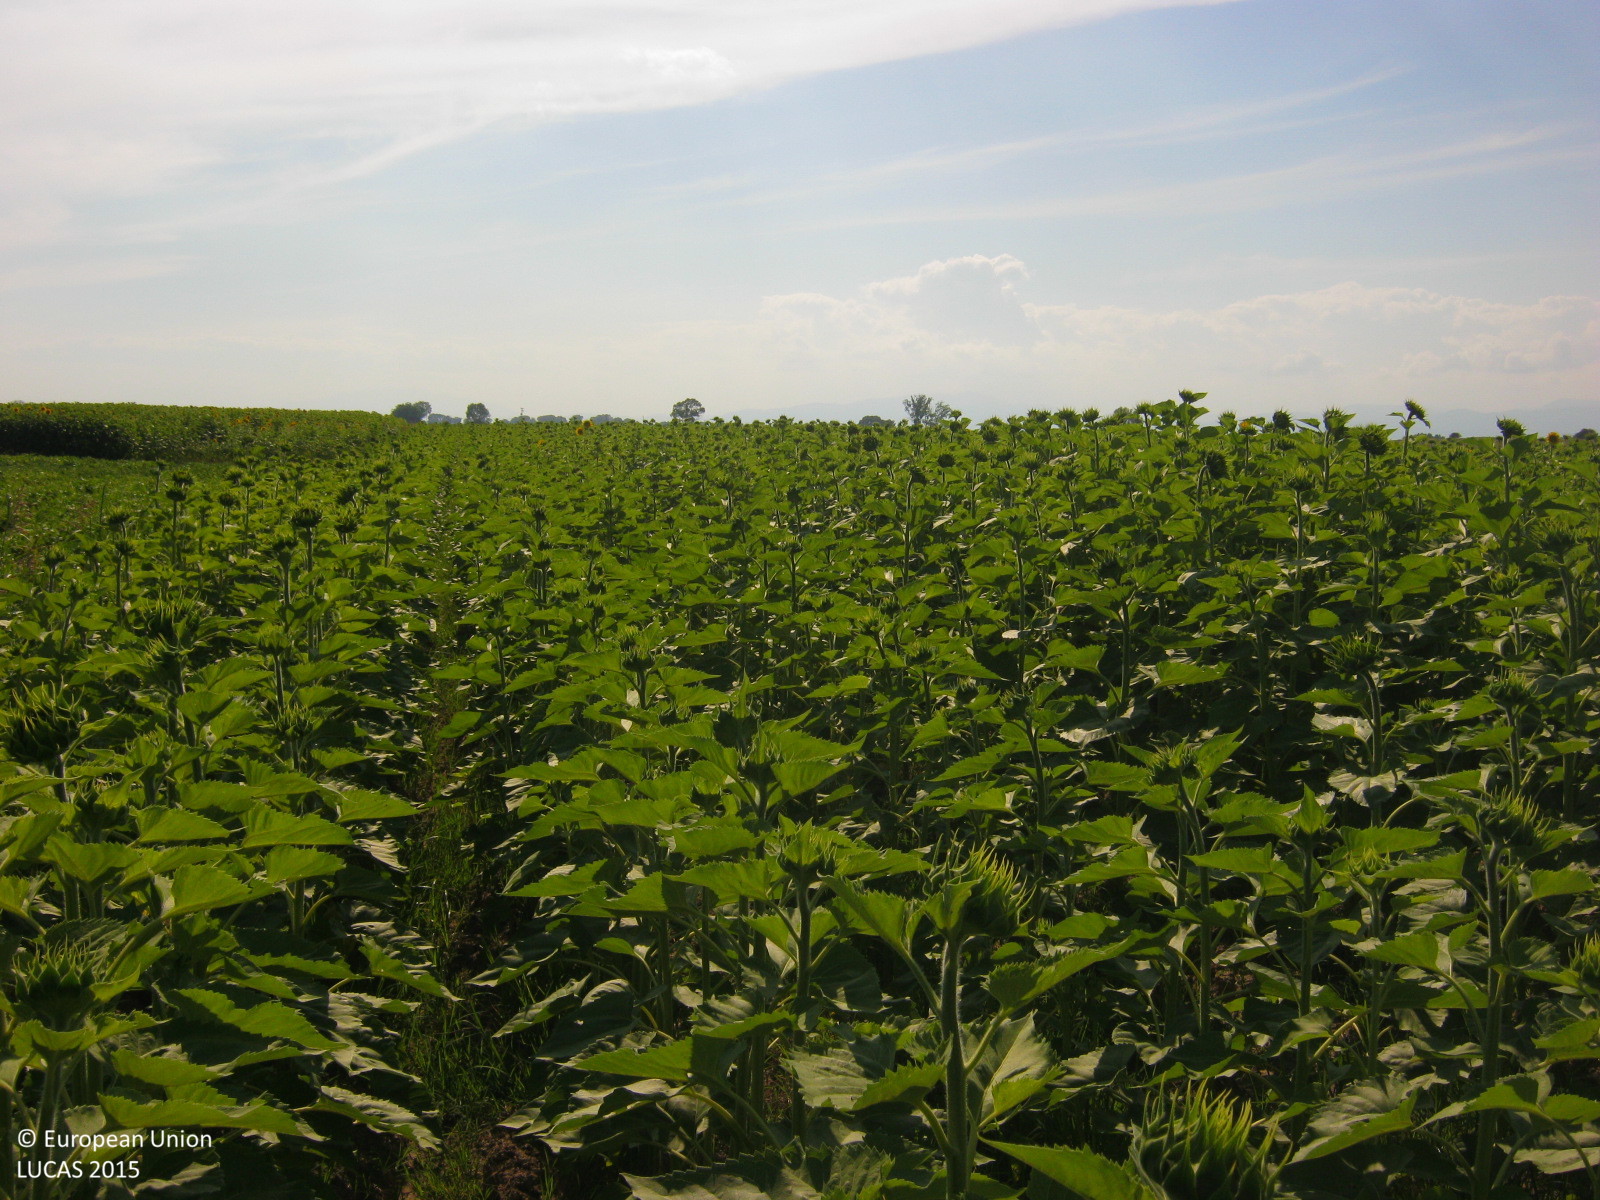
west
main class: Cropland
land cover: Sunflower
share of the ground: > 75 %
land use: Agriculture (excluding fallow land and kitchen gardens)
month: June
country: GR
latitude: 40.9505
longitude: 24.9489
